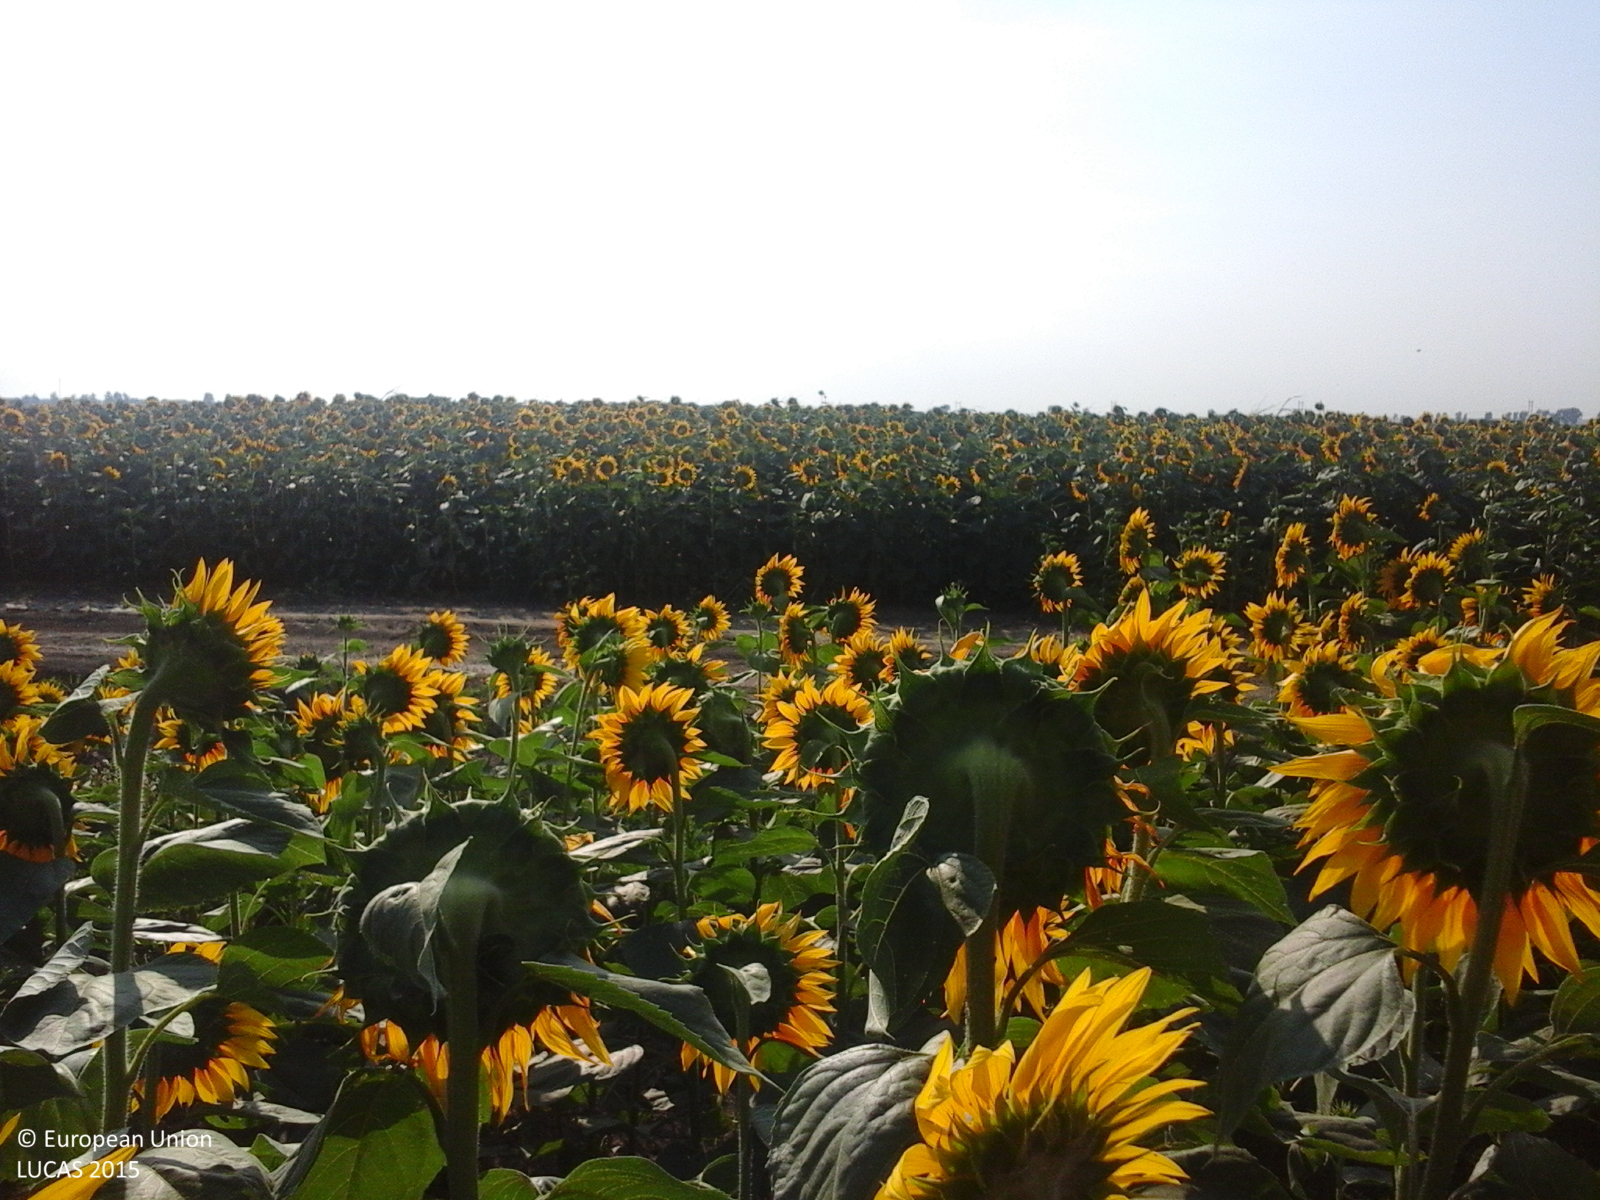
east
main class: Cropland
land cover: Sunflower
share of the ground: > 75 %
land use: Agriculture (excluding fallow land and kitchen gardens)
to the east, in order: Sunflower; Tracks; Sunflower
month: July
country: RO
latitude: 44.5876
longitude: 27.0214
